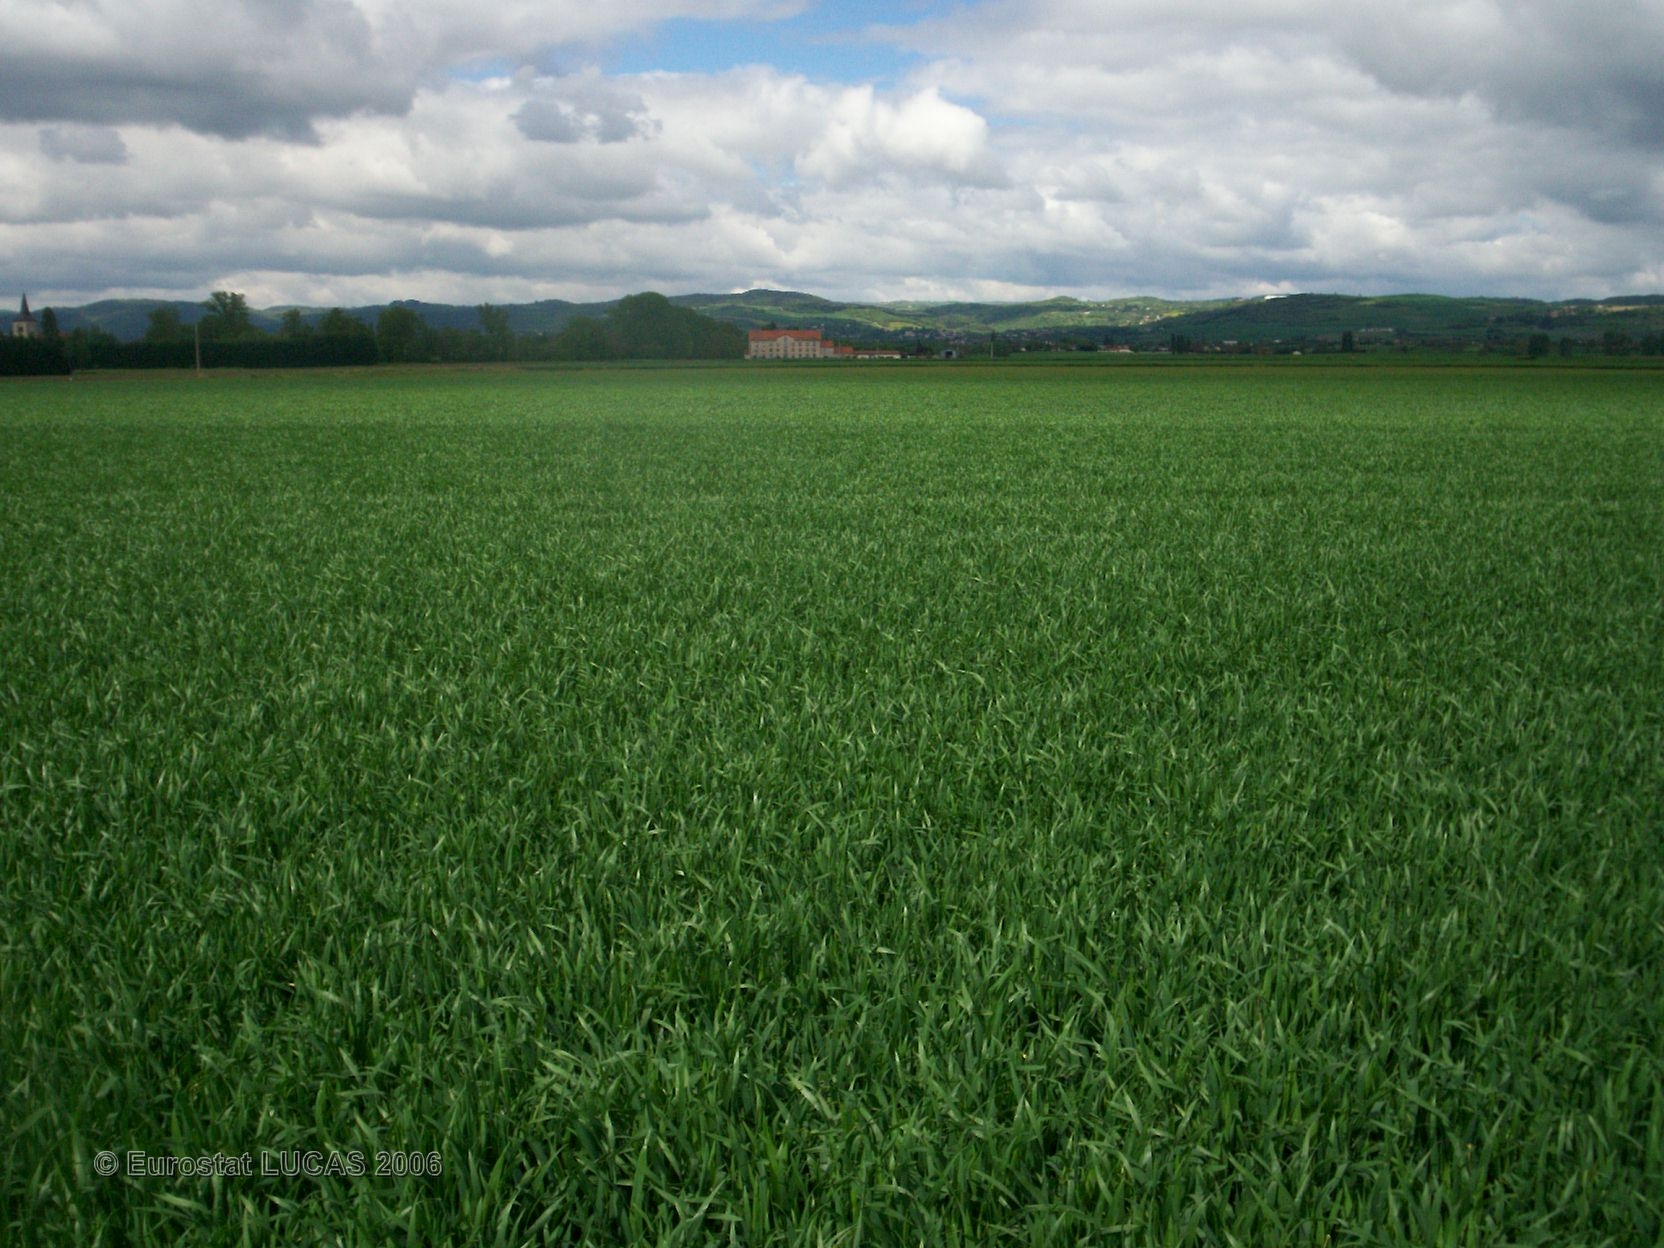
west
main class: Cropland
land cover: Common wheat
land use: Agriculture (excluding fallow land and kitchen gardens)
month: May
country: FR
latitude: 45.9507
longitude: 3.1489
